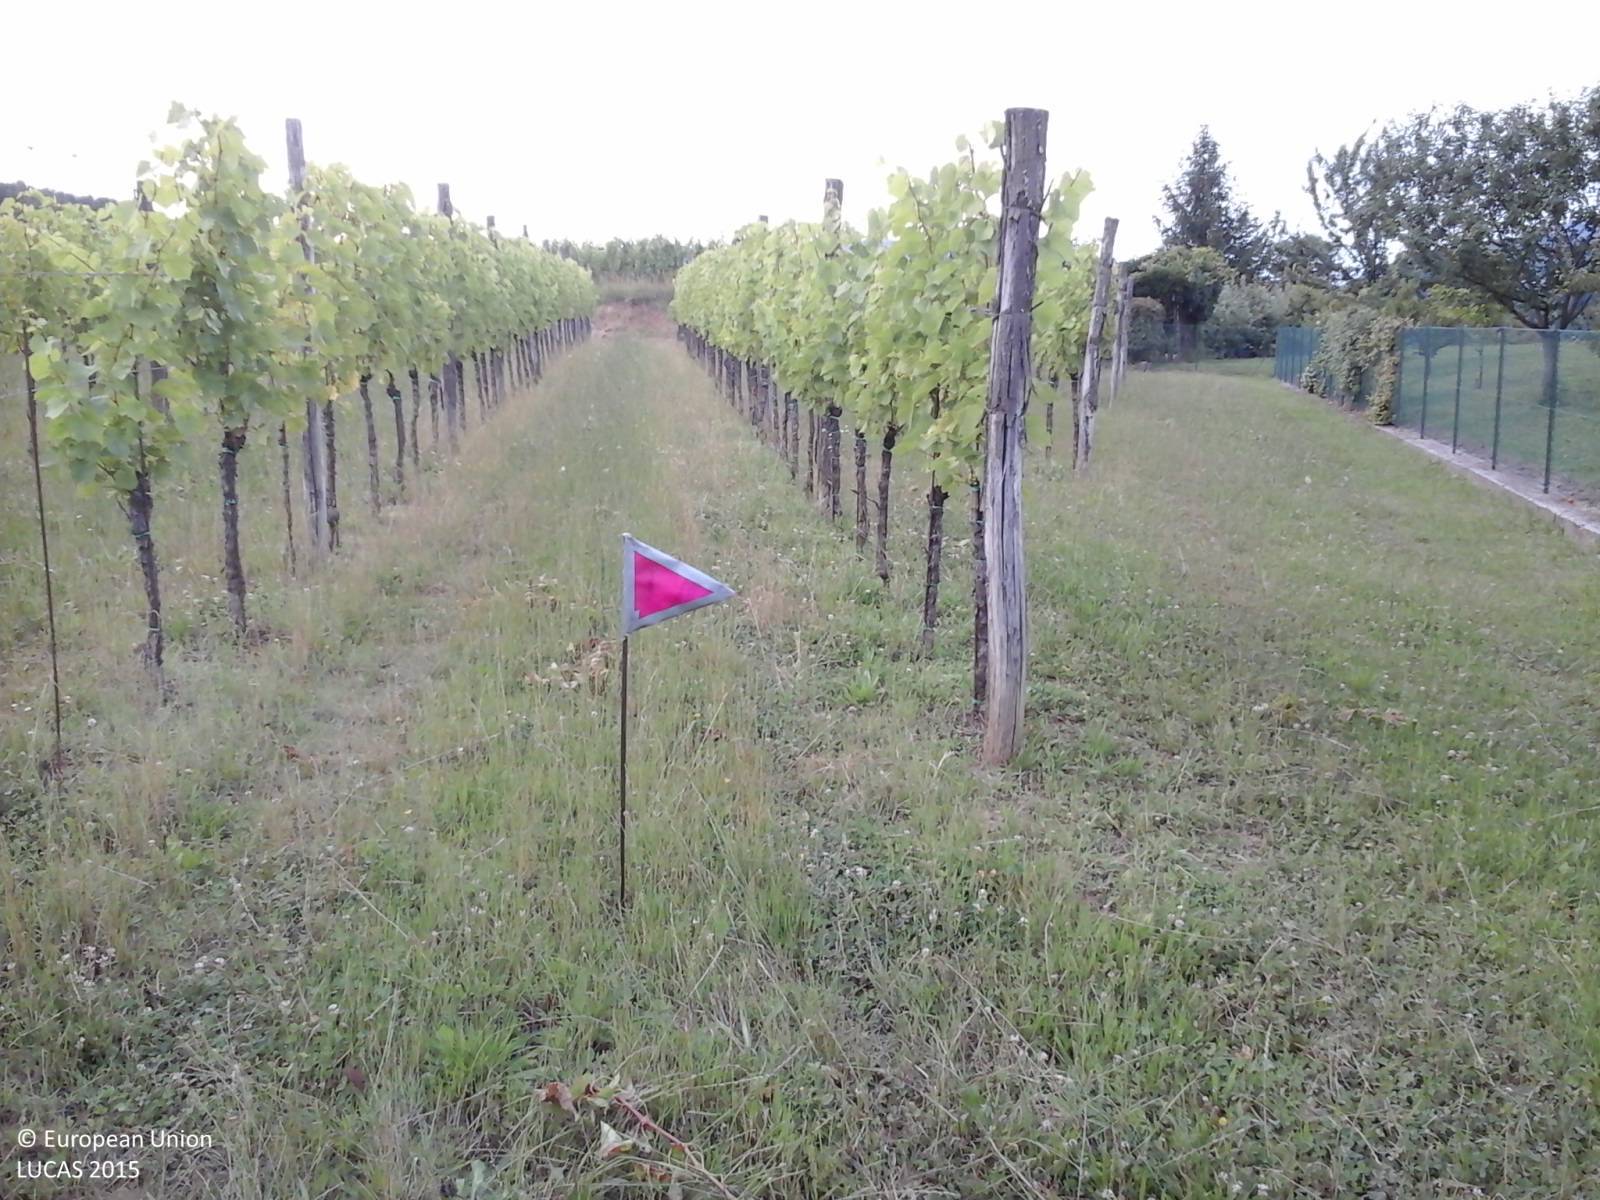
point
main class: Cropland
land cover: Vineyards
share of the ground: 25 - 50 %
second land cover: Grassland without tree/shrub cover
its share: 50 - 75 %
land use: Agriculture (excluding fallow land and kitchen gardens)
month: June
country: IT
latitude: 46.0245
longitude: 13.4712
